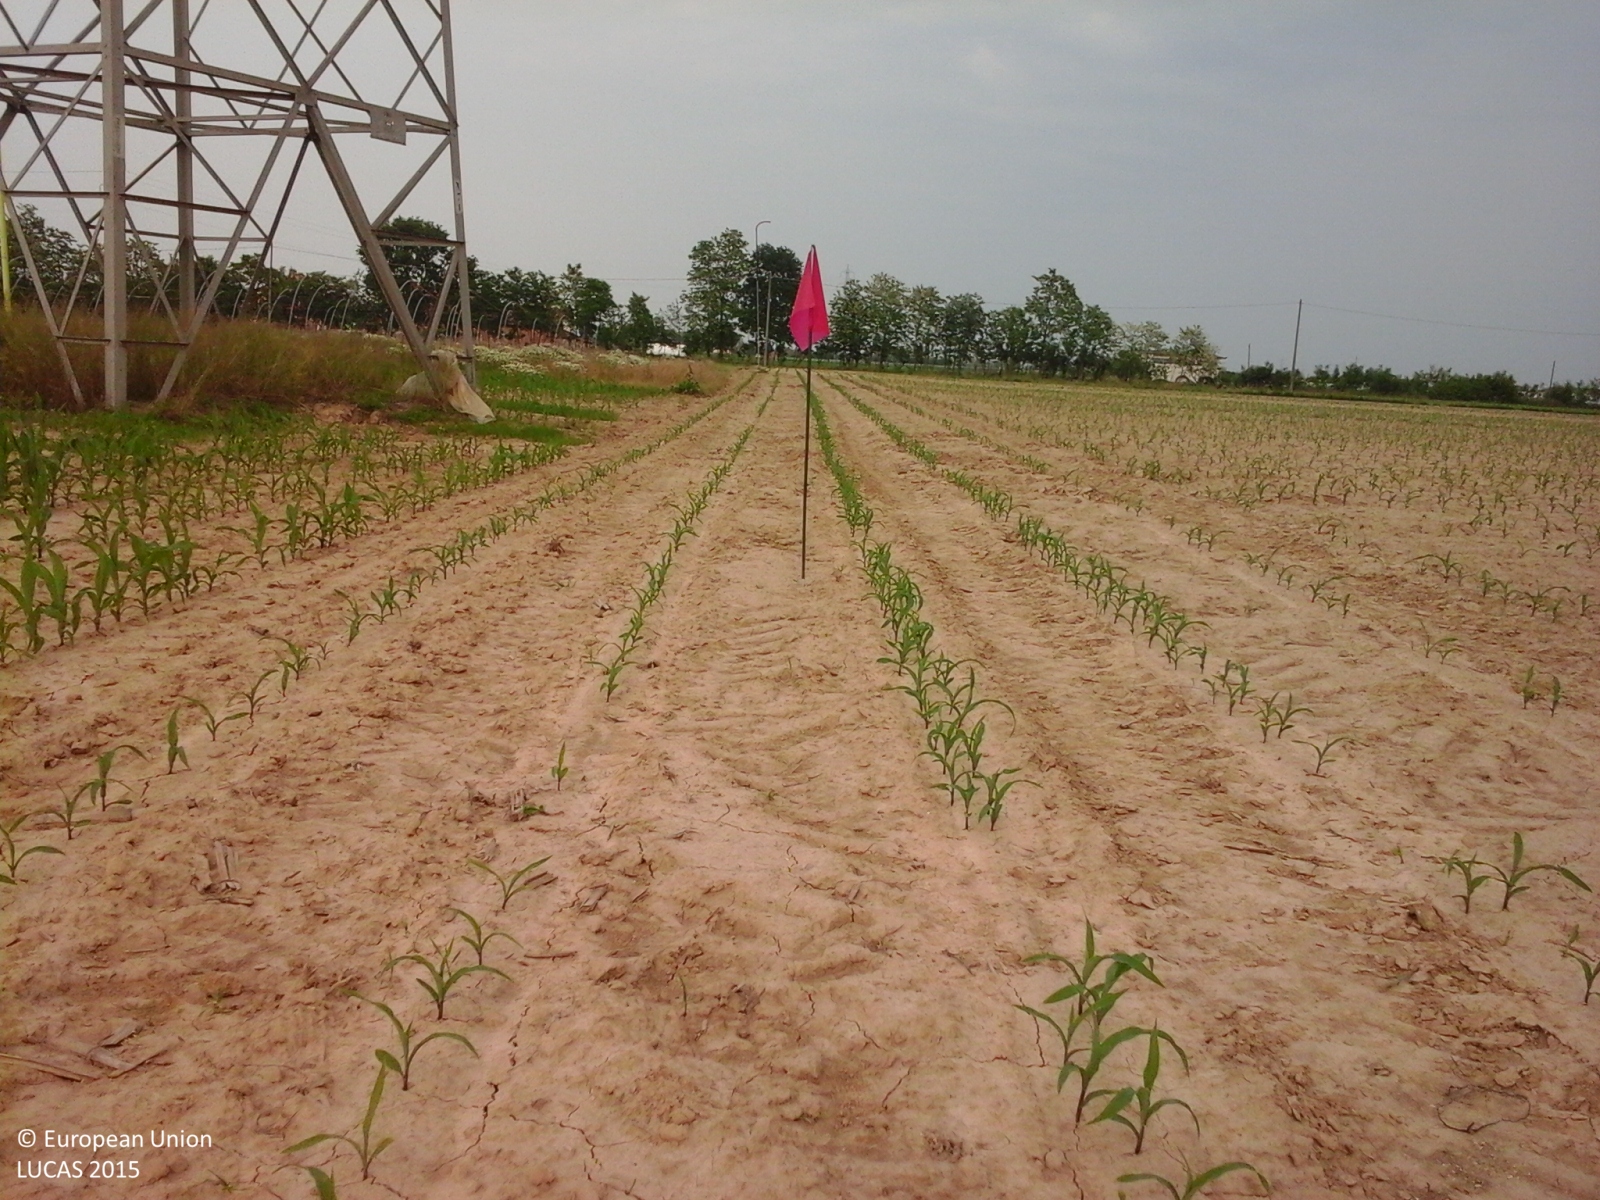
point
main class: Cropland
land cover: Maize
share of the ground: < 10 %
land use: Agriculture (excluding fallow land and kitchen gardens)
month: May
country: IT
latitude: 44.8671
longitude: 7.7387
